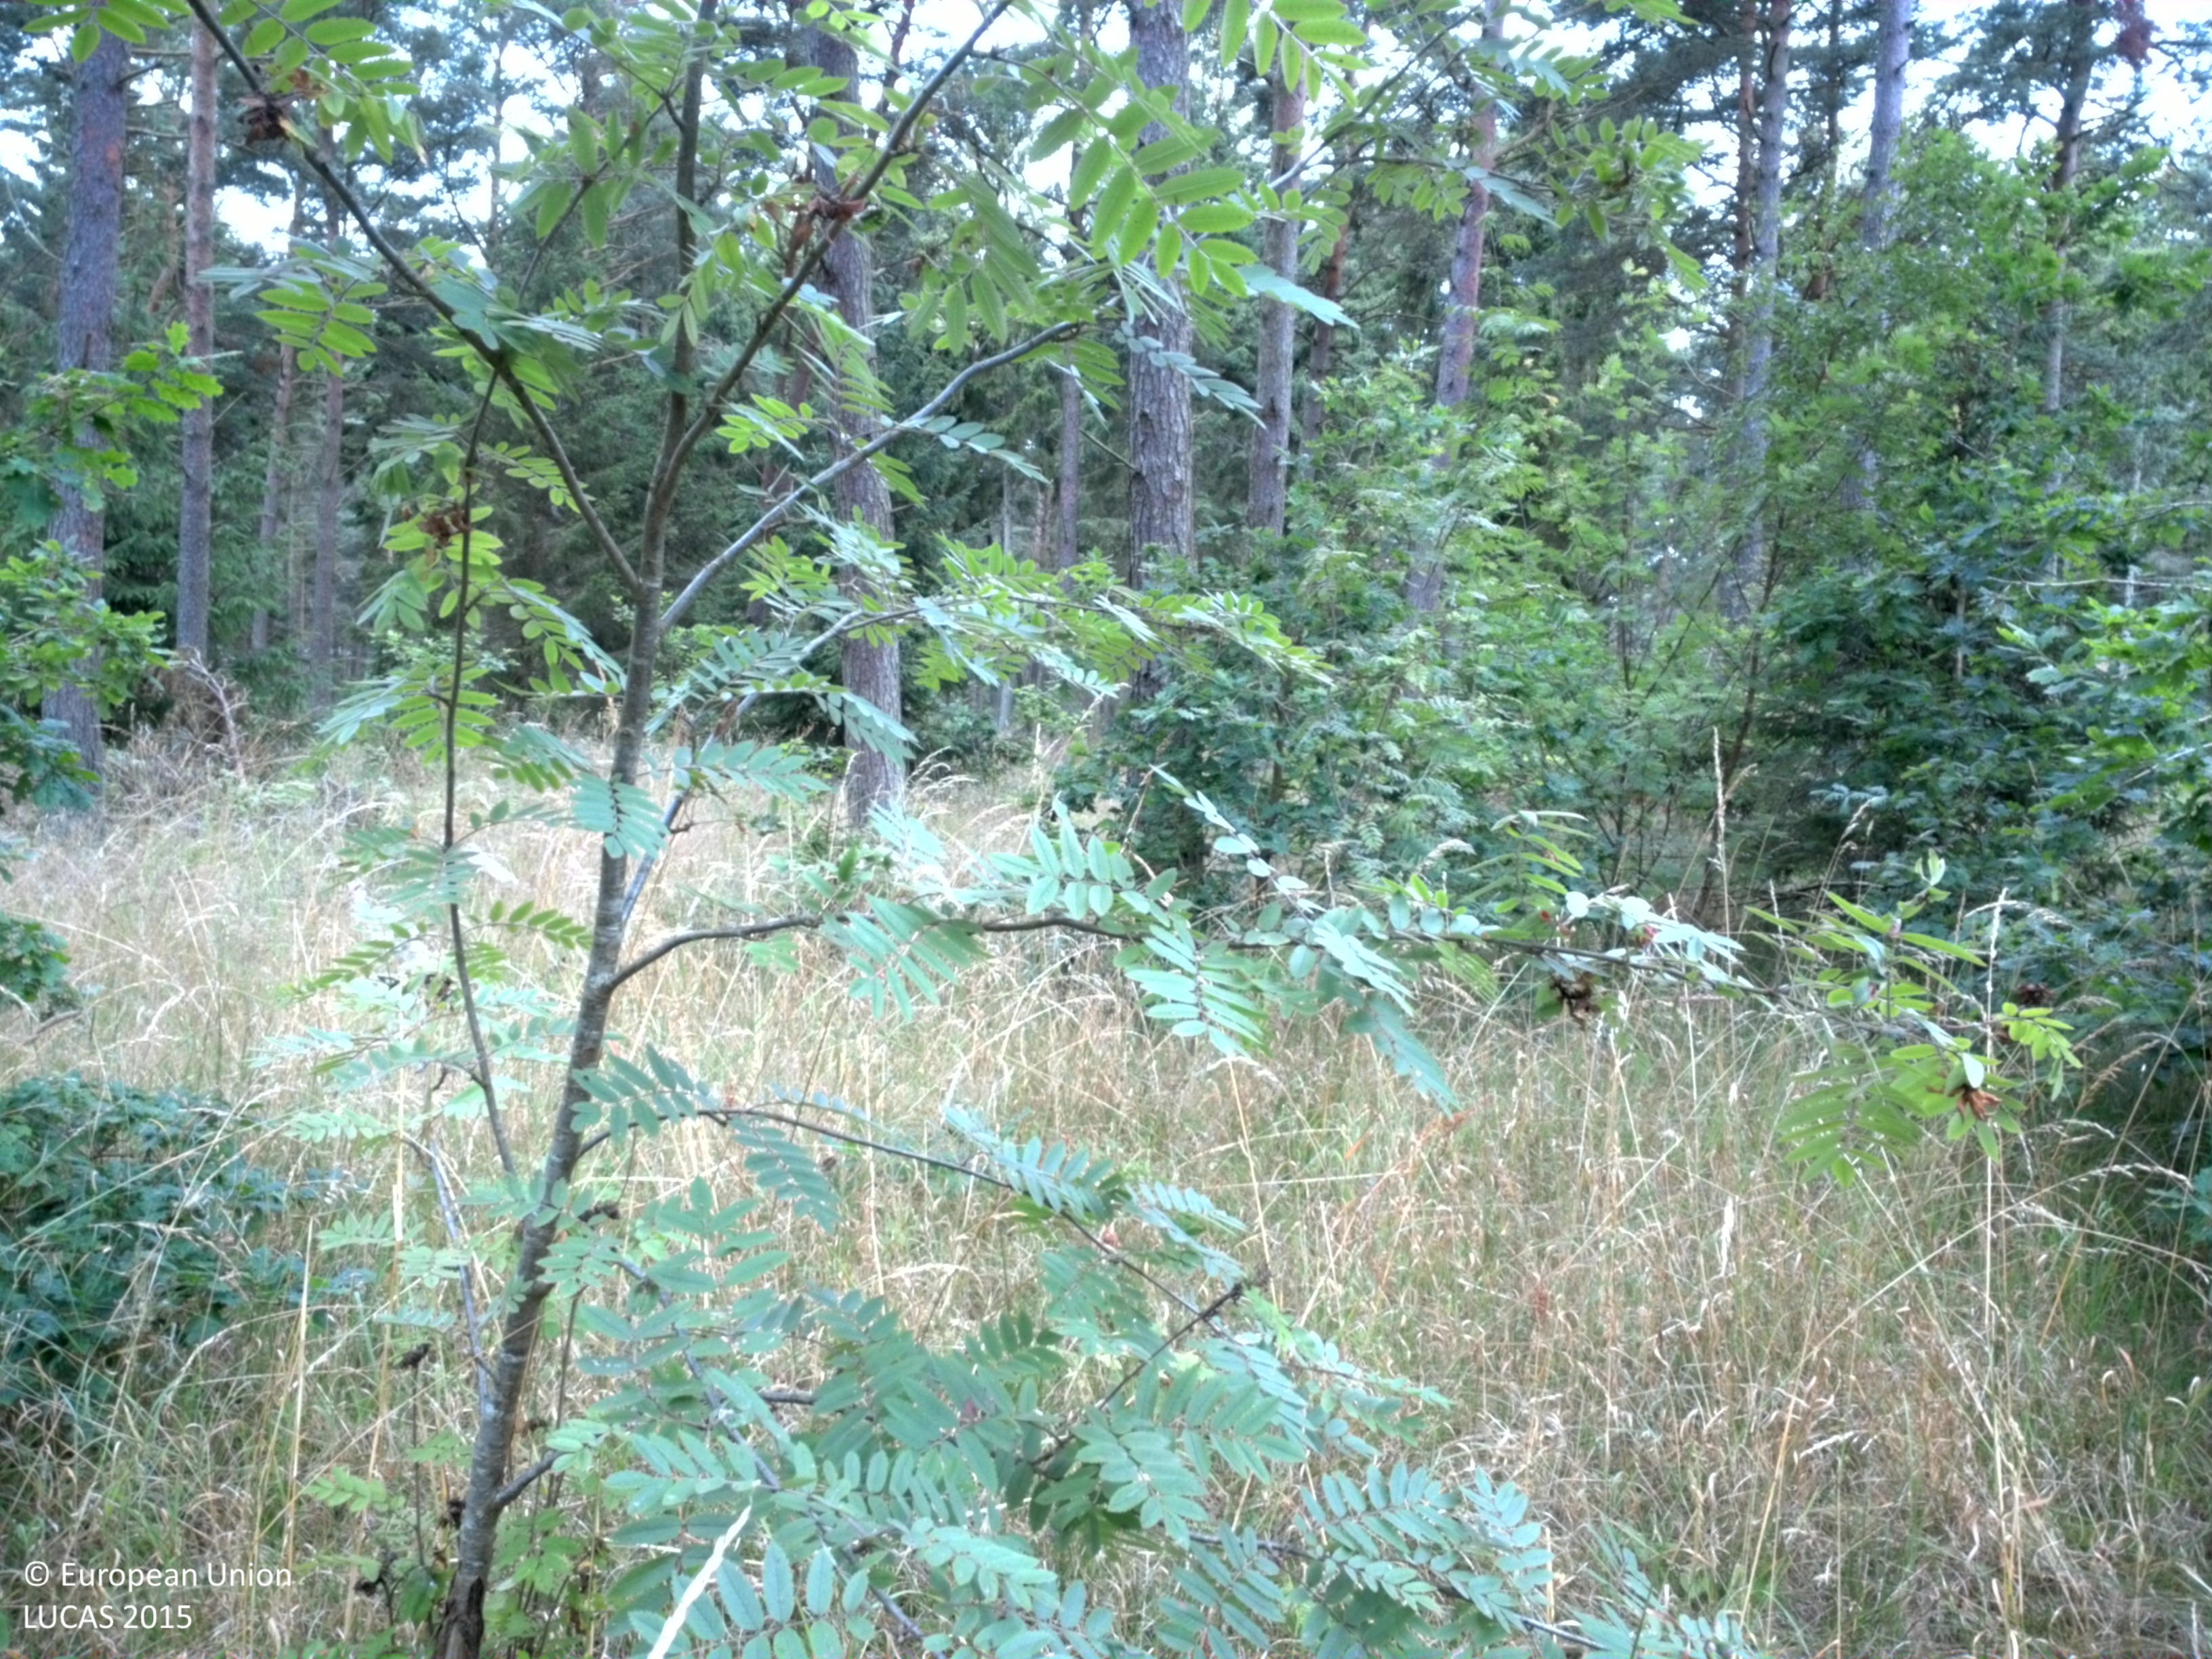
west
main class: Woodland
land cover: Pine dominated mixed woodland
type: hemiboreal forest and nemoral coniferous forest and mixed broadleaved-coniferous forest
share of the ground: > 75 %
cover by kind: coniferous forest trees 50 %, broadleaved forest trees 25 %, herbaceous plants 20 %, shrubs 5 %
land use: Forestry
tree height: > 5 m
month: July
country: SE
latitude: 57.2328
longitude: 18.6749
